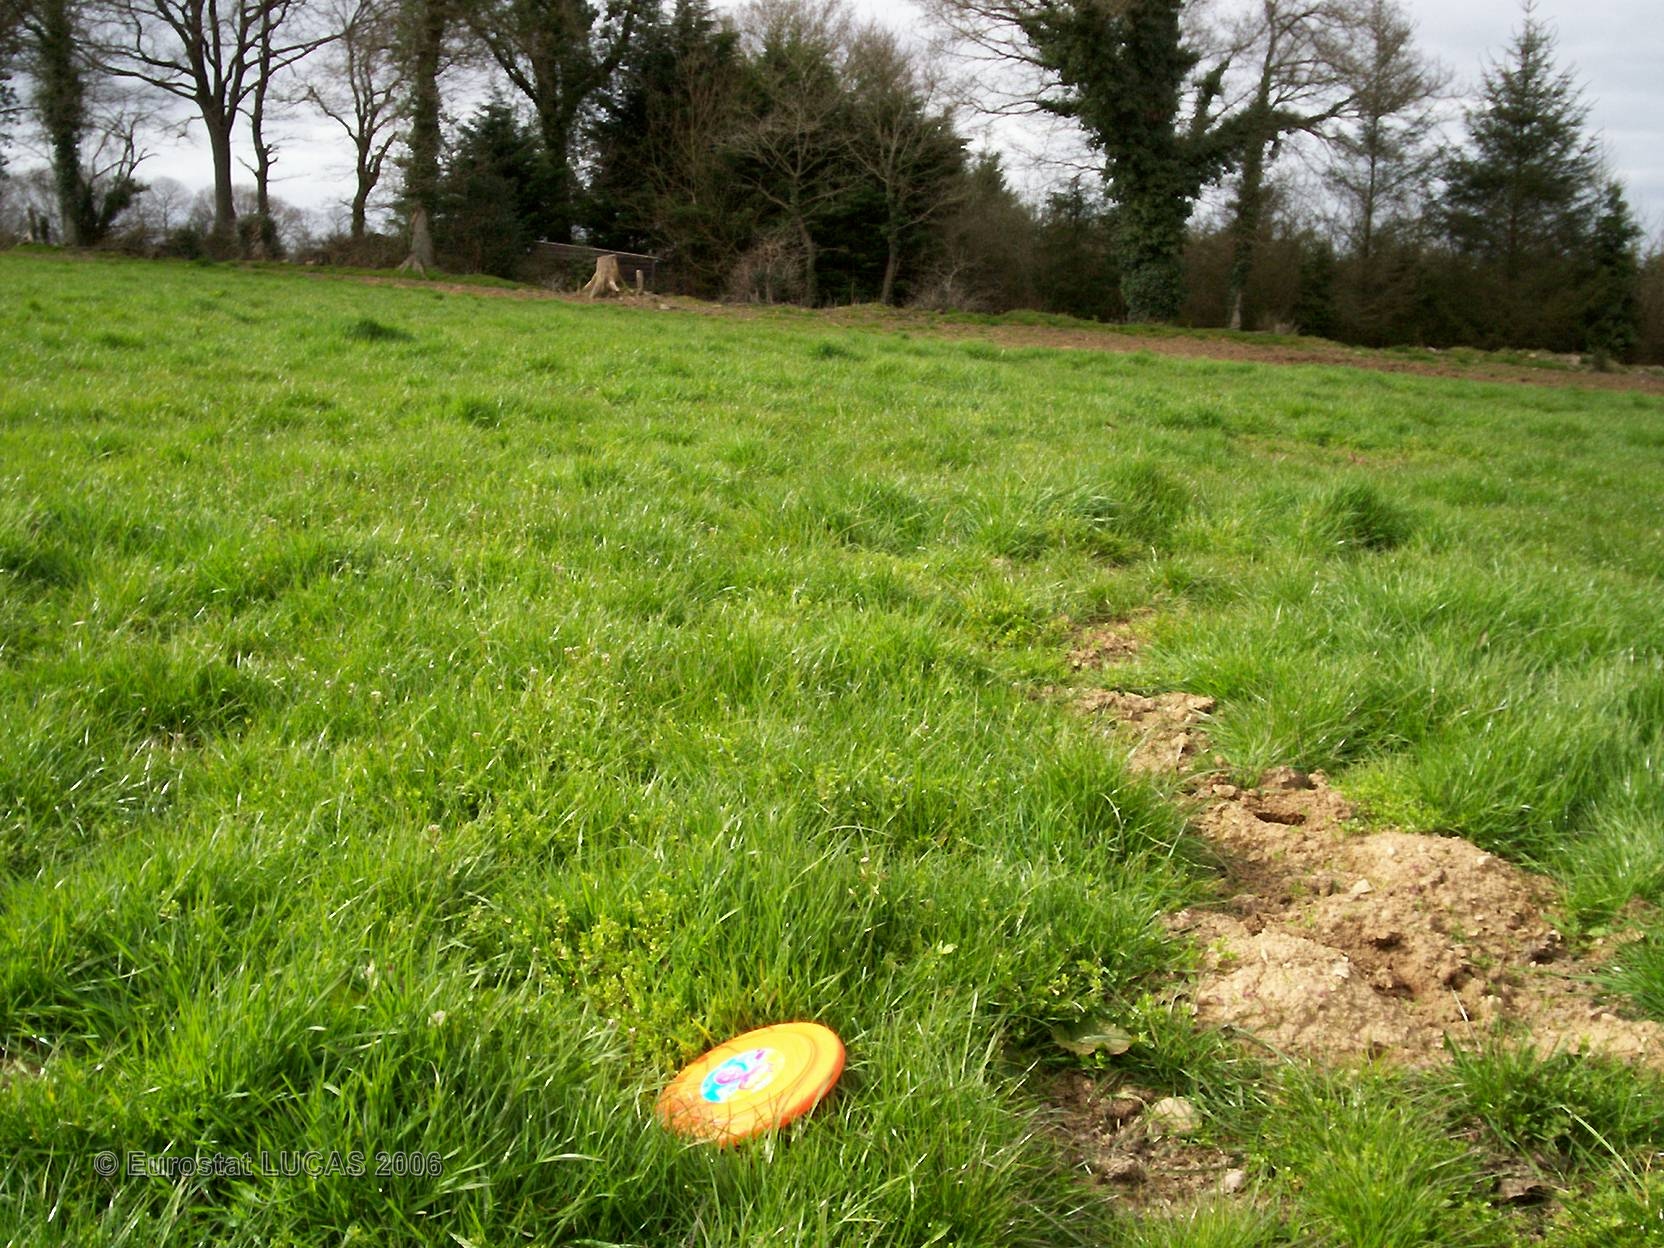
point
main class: Grassland
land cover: Grassland without tree/shrub cover
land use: Agriculture (excluding fallow land and kitchen gardens)
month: April
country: FR
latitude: 48.2079
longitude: -3.6584
